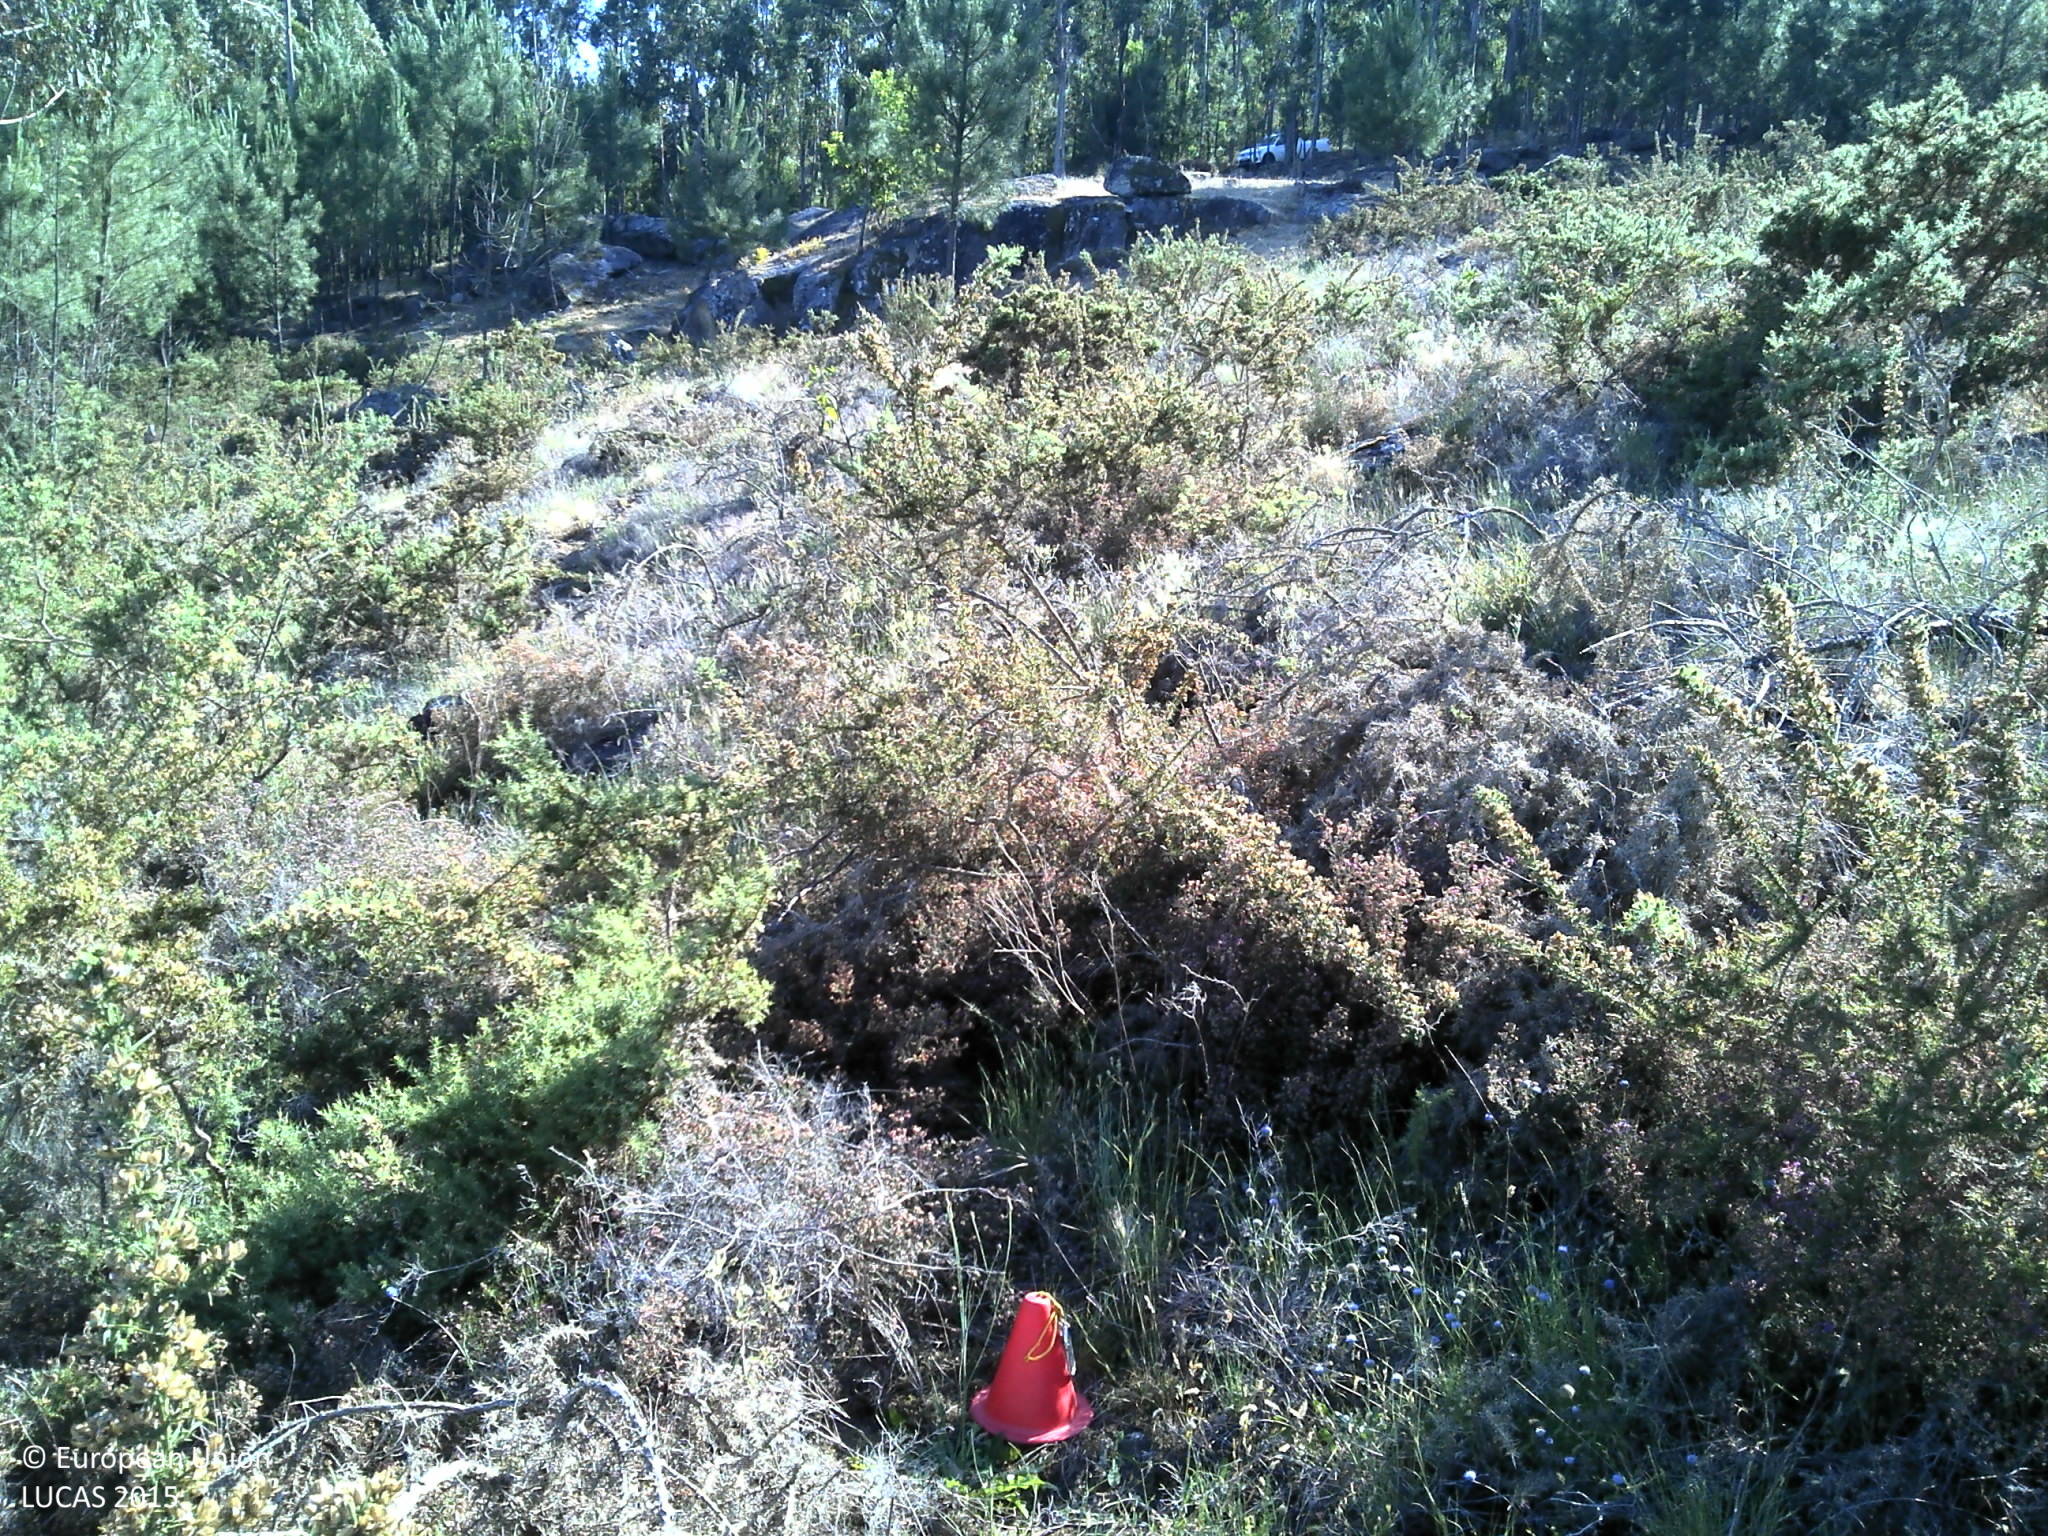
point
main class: Shrubland
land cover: Shrubland without tree cover
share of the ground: > 75 %
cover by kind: shrubs 80 %, herbaceous plants 10 %, unconsolidated bare surface 10 %
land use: Semi-natural and natural areas not in use
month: May
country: PT
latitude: 41.7542
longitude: -8.6488
